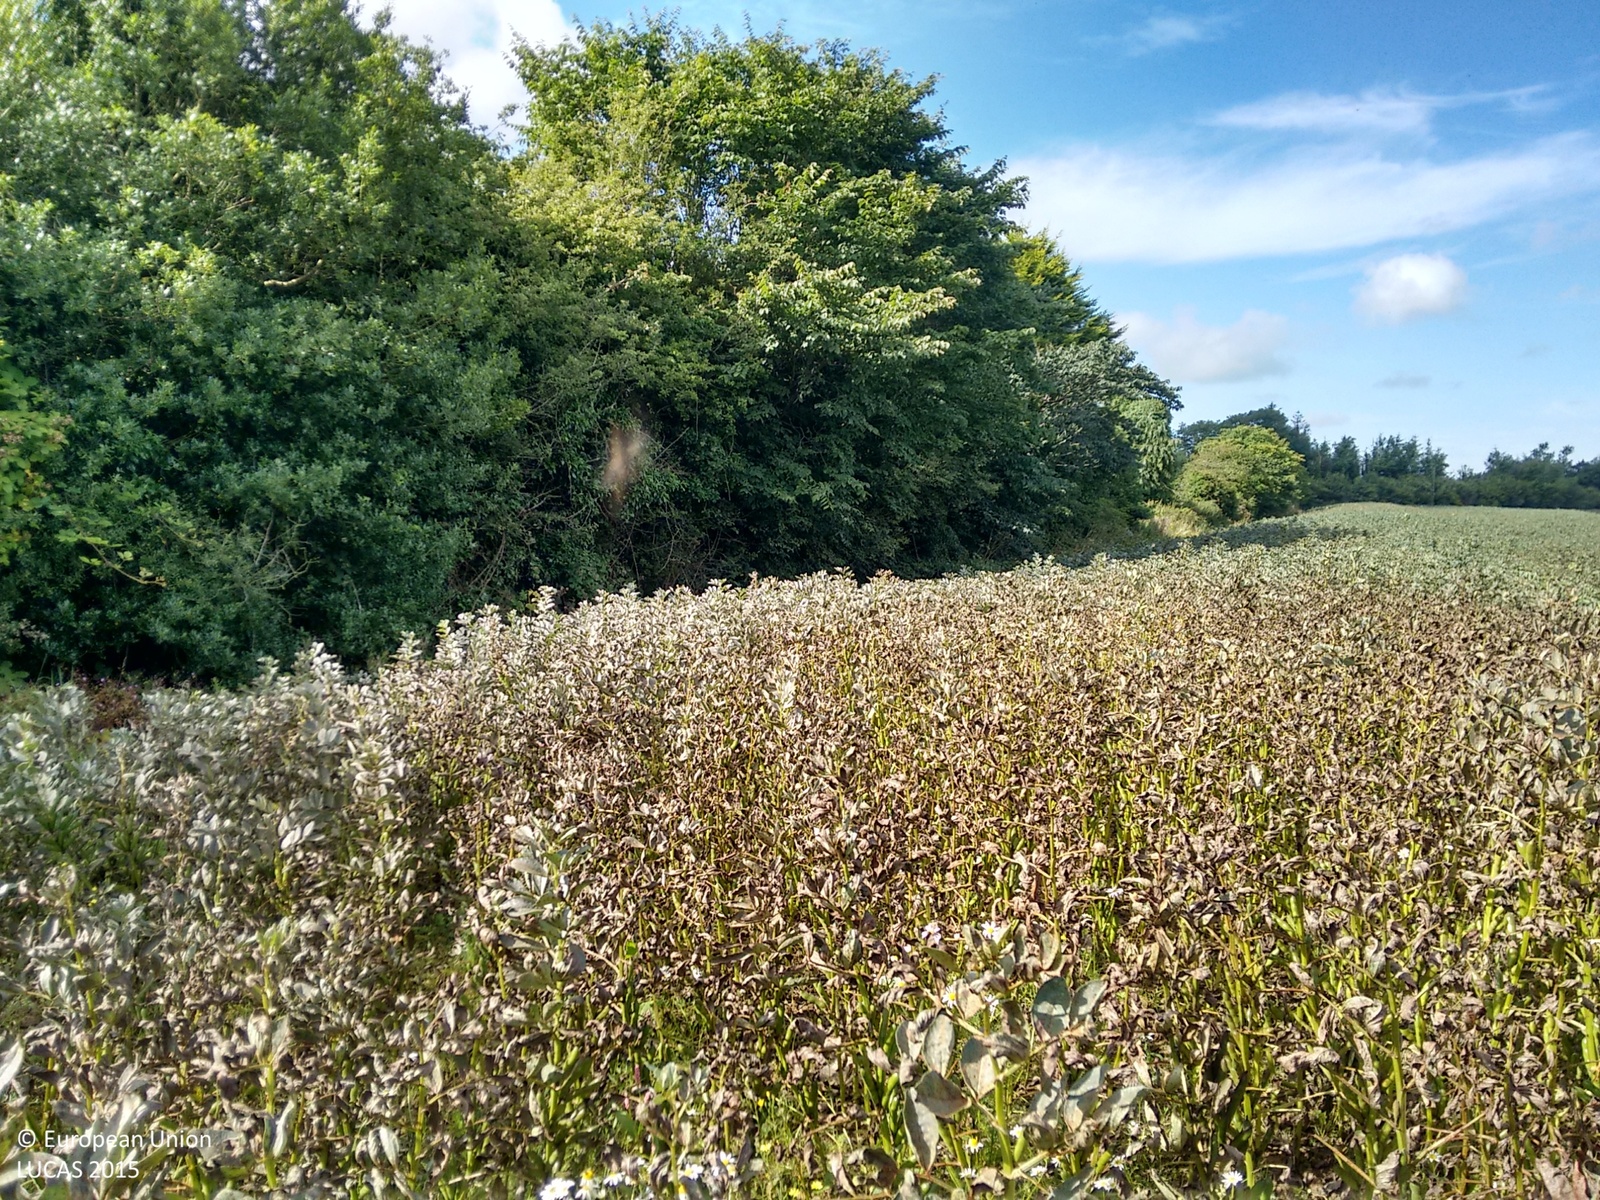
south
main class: Cropland
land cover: Dry pulses
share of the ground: > 75 %
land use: Agriculture (excluding fallow land and kitchen gardens)
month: August
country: IE
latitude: 52.5360
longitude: -6.3554
